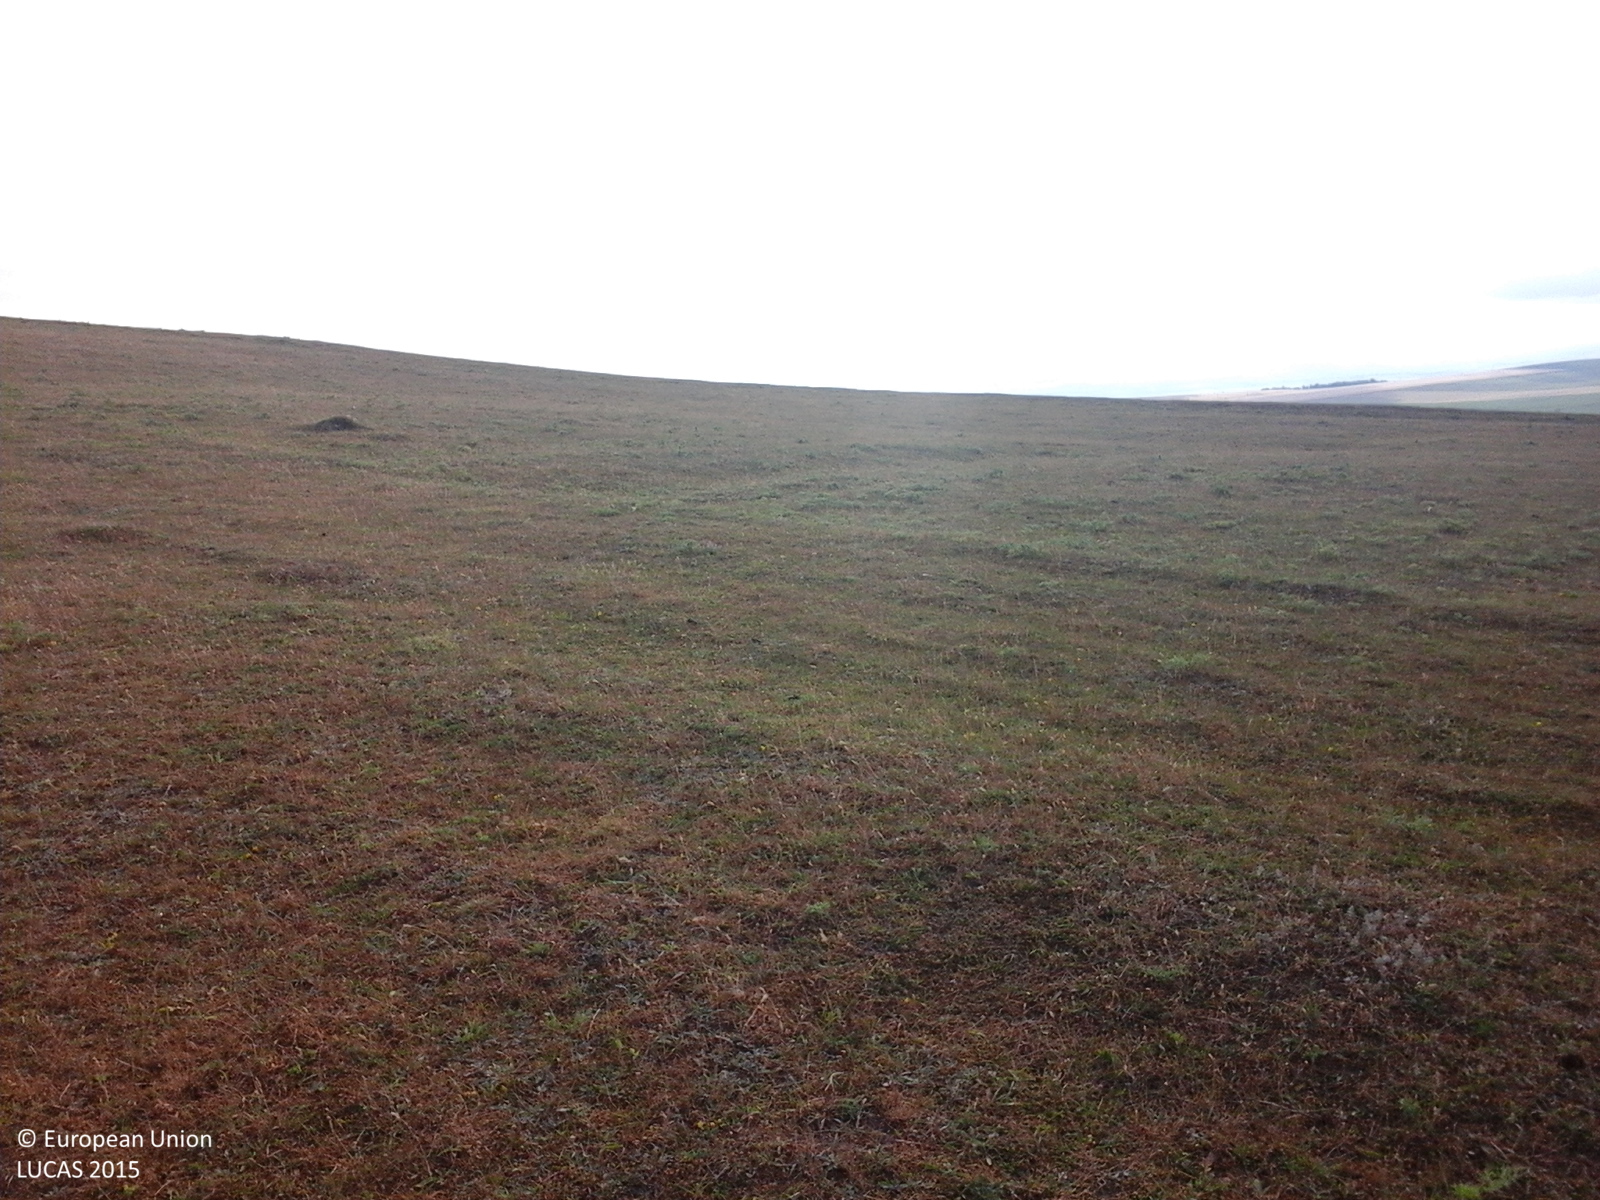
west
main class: Grassland
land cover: Grassland without tree/shrub cover
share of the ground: > 75 %
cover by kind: herbaceous plants 100 %
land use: Agriculture (excluding fallow land and kitchen gardens)
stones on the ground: < 10 %
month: June
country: RO
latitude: 47.2510
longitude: 26.8104
